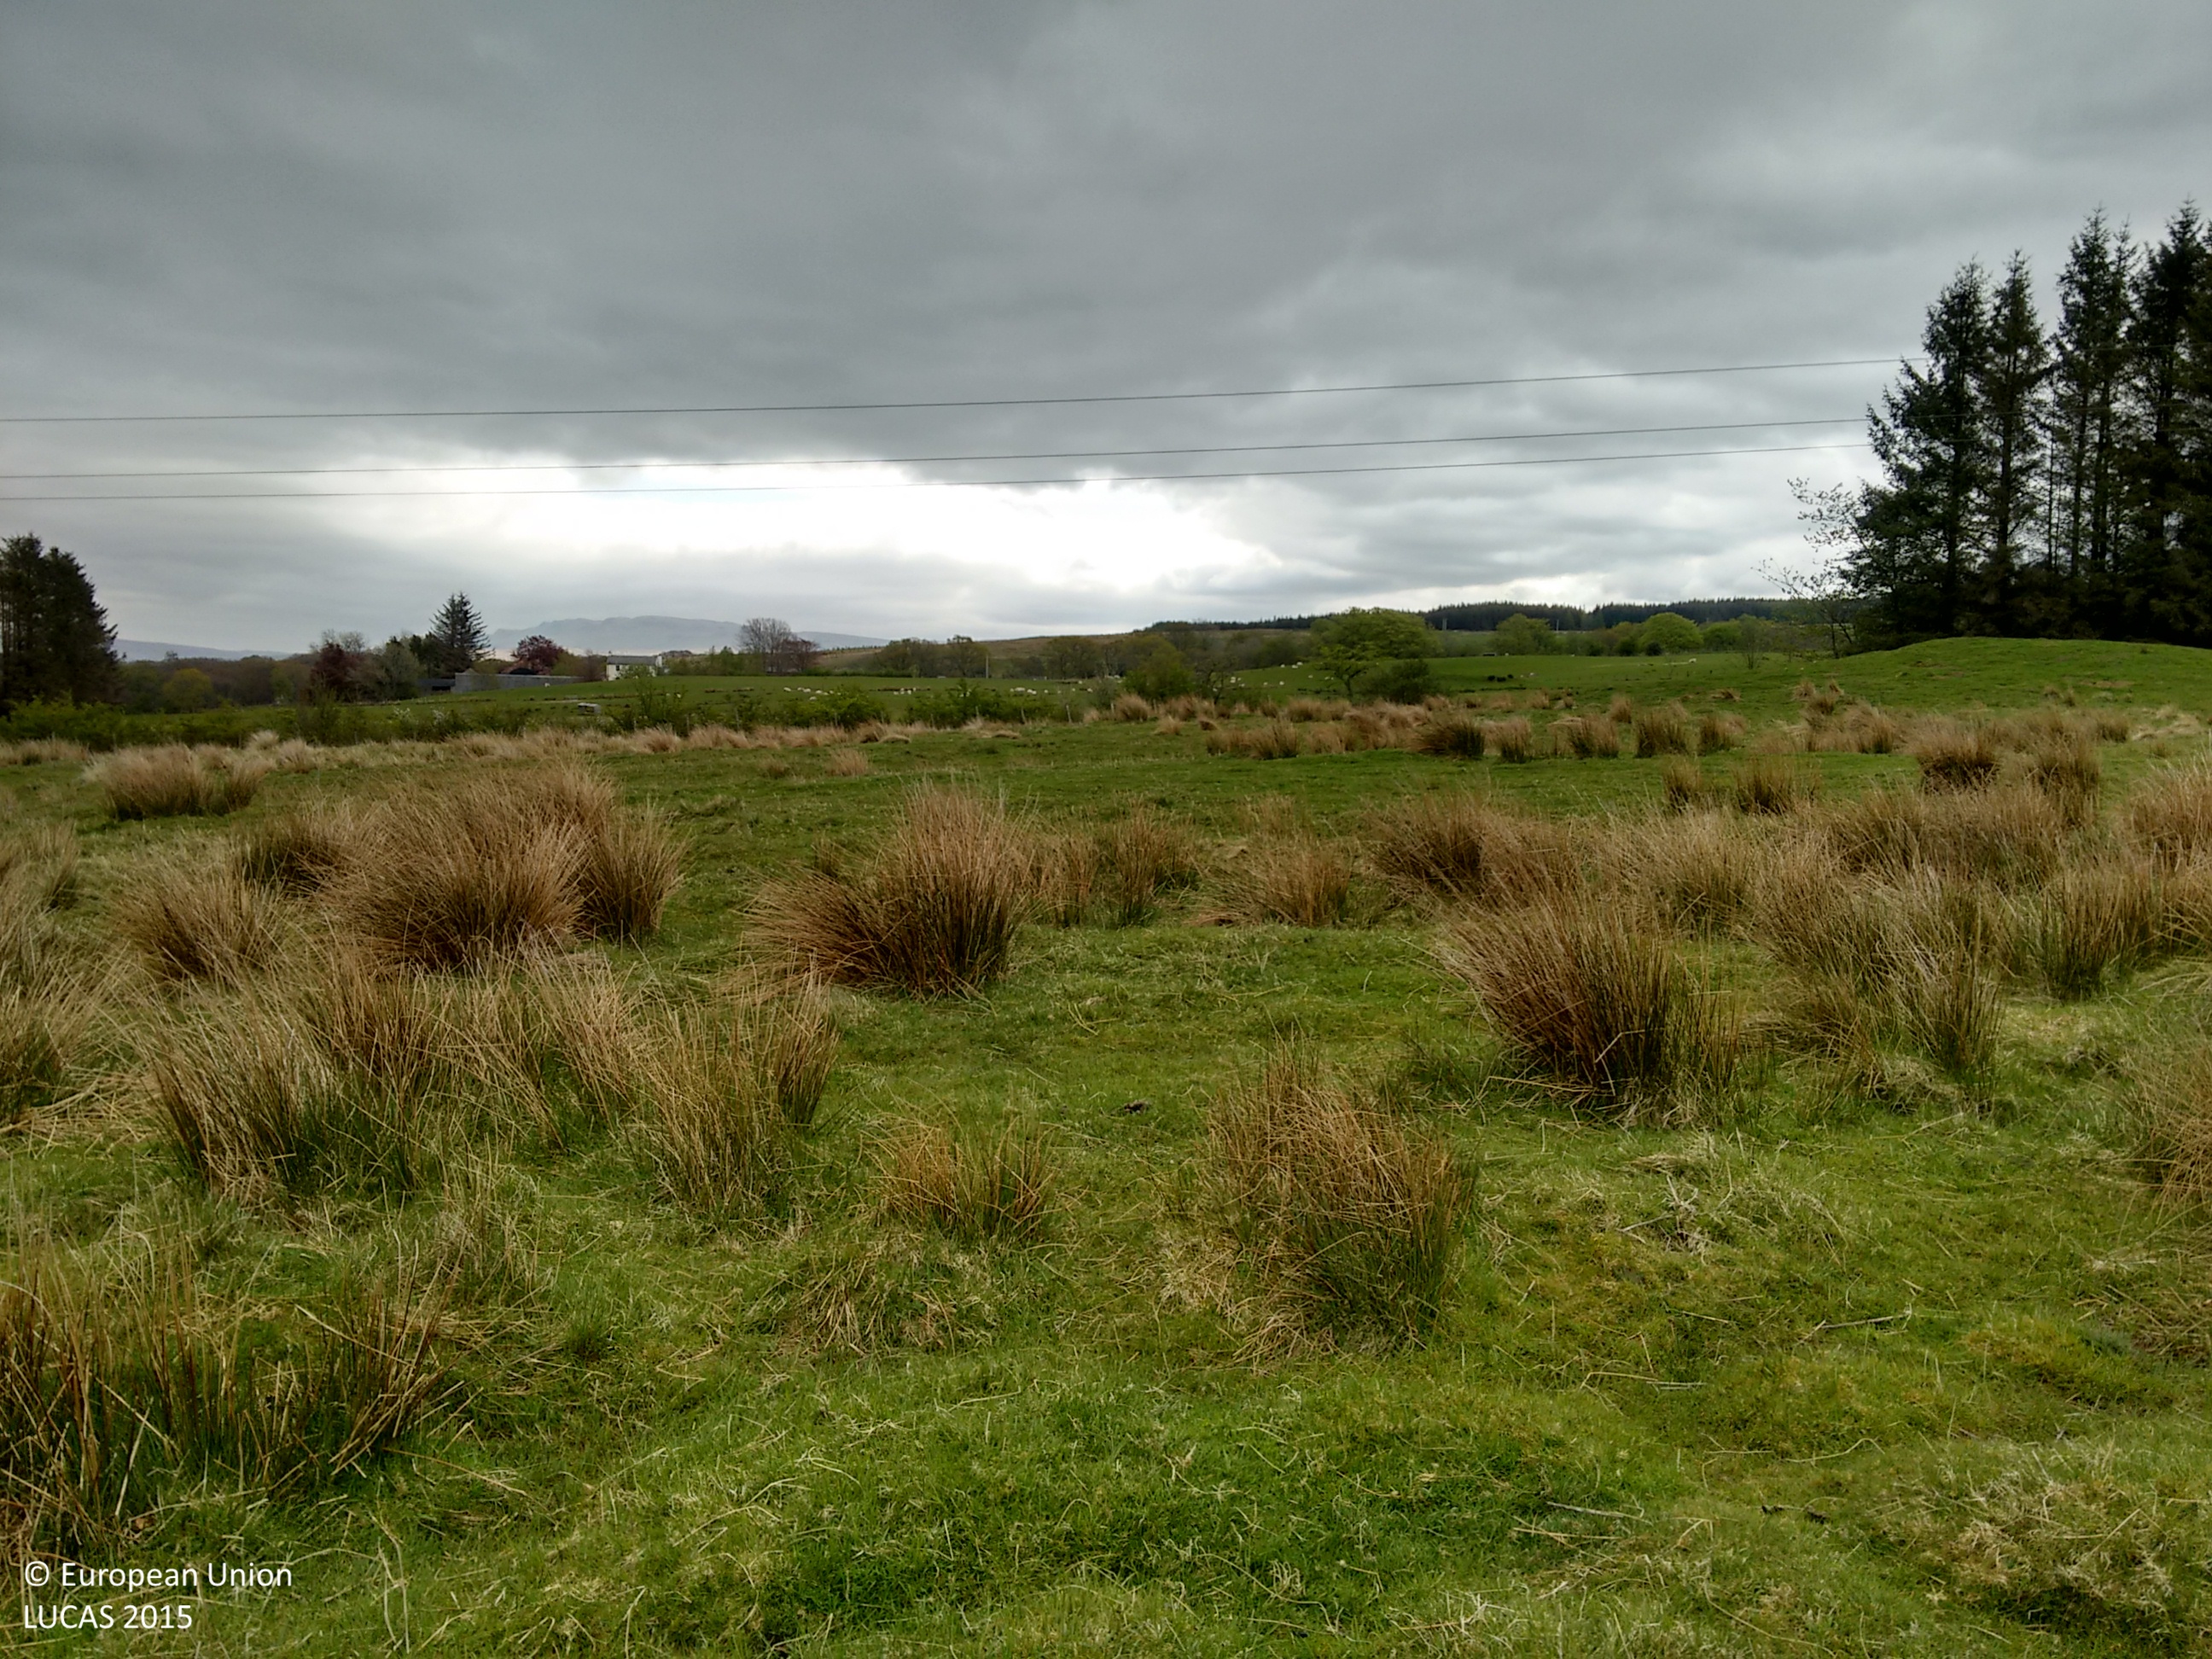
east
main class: Grassland
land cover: Grassland without tree/shrub cover
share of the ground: > 75 %
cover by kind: herbaceous plants 95 %, lichens and mosses 5 %
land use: Agriculture (excluding fallow land and kitchen gardens)
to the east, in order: Grassland without tree/shrub cover; Electric lines; Grassland without tree/shrub cover; Fences; Shruby margins; Rivers and streams; Grass margins; Fences; Grassland without tree/shrub cover
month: May
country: GB
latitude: 56.0183
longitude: -4.4878
